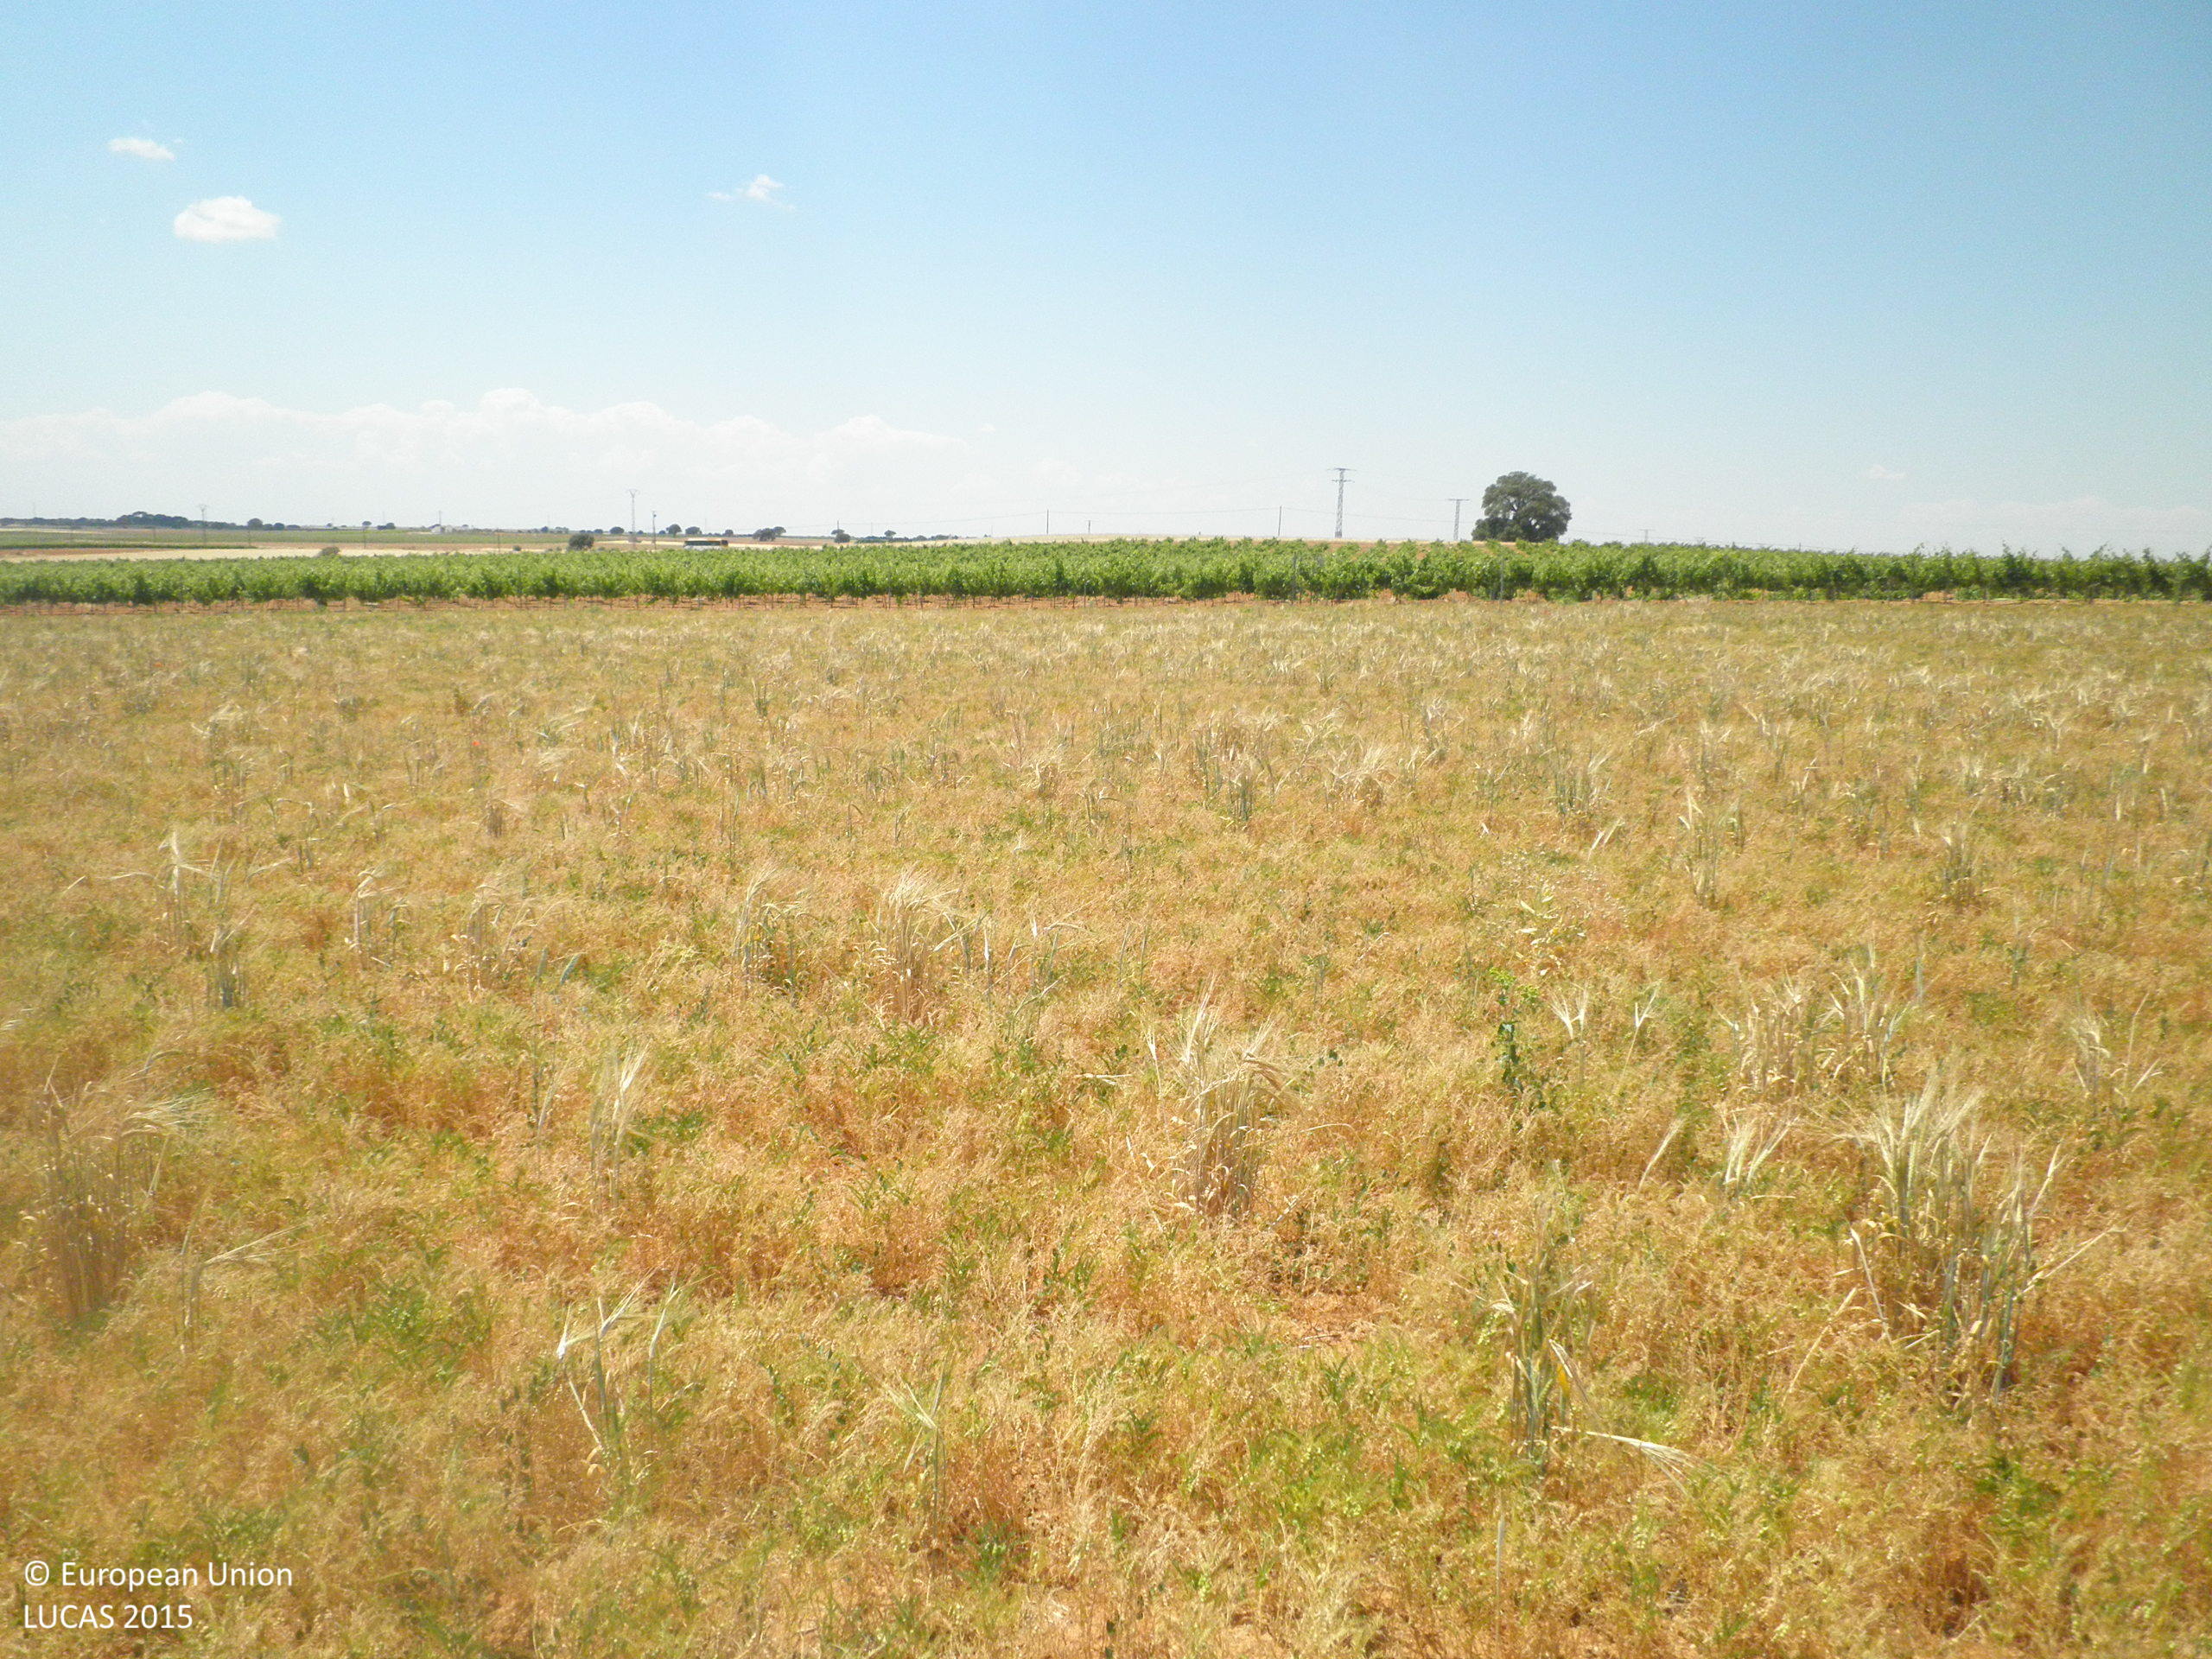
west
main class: Cropland
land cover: Dry pulses
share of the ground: 50 - 75 %
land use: Agriculture (excluding fallow land and kitchen gardens)
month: June
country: ES
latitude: 39.3207
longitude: -1.7537
